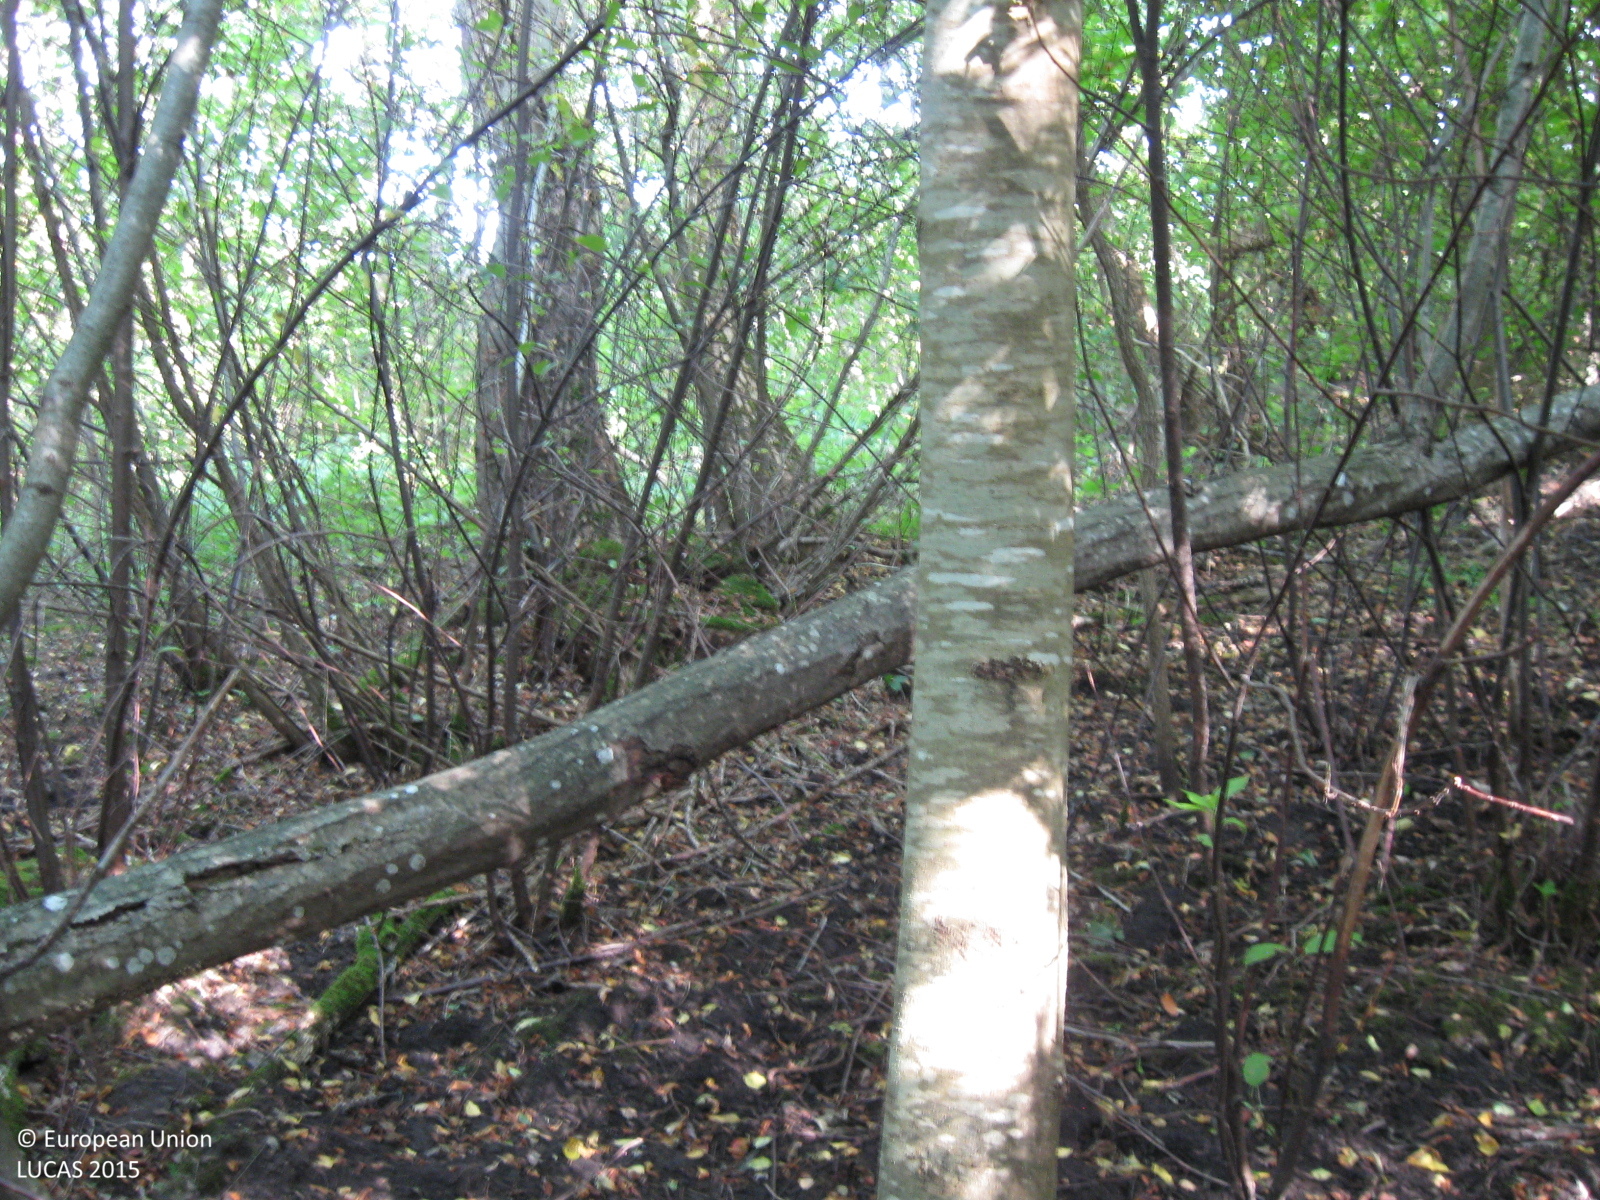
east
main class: Woodland
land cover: Broadleaved woodland
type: non-riverine alder, birch or aspen forest
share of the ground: > 75 %
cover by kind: broadleaved forest trees 95 %, unconsolidated bare surface 5 %
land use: Forestry
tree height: > 5 m
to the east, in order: Broadleaved woodland; Spontaneously vegetated surfaces; Barley; Grassland without tree/shrub cover; Oats
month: August
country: LT
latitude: 55.4636
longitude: 23.2169
